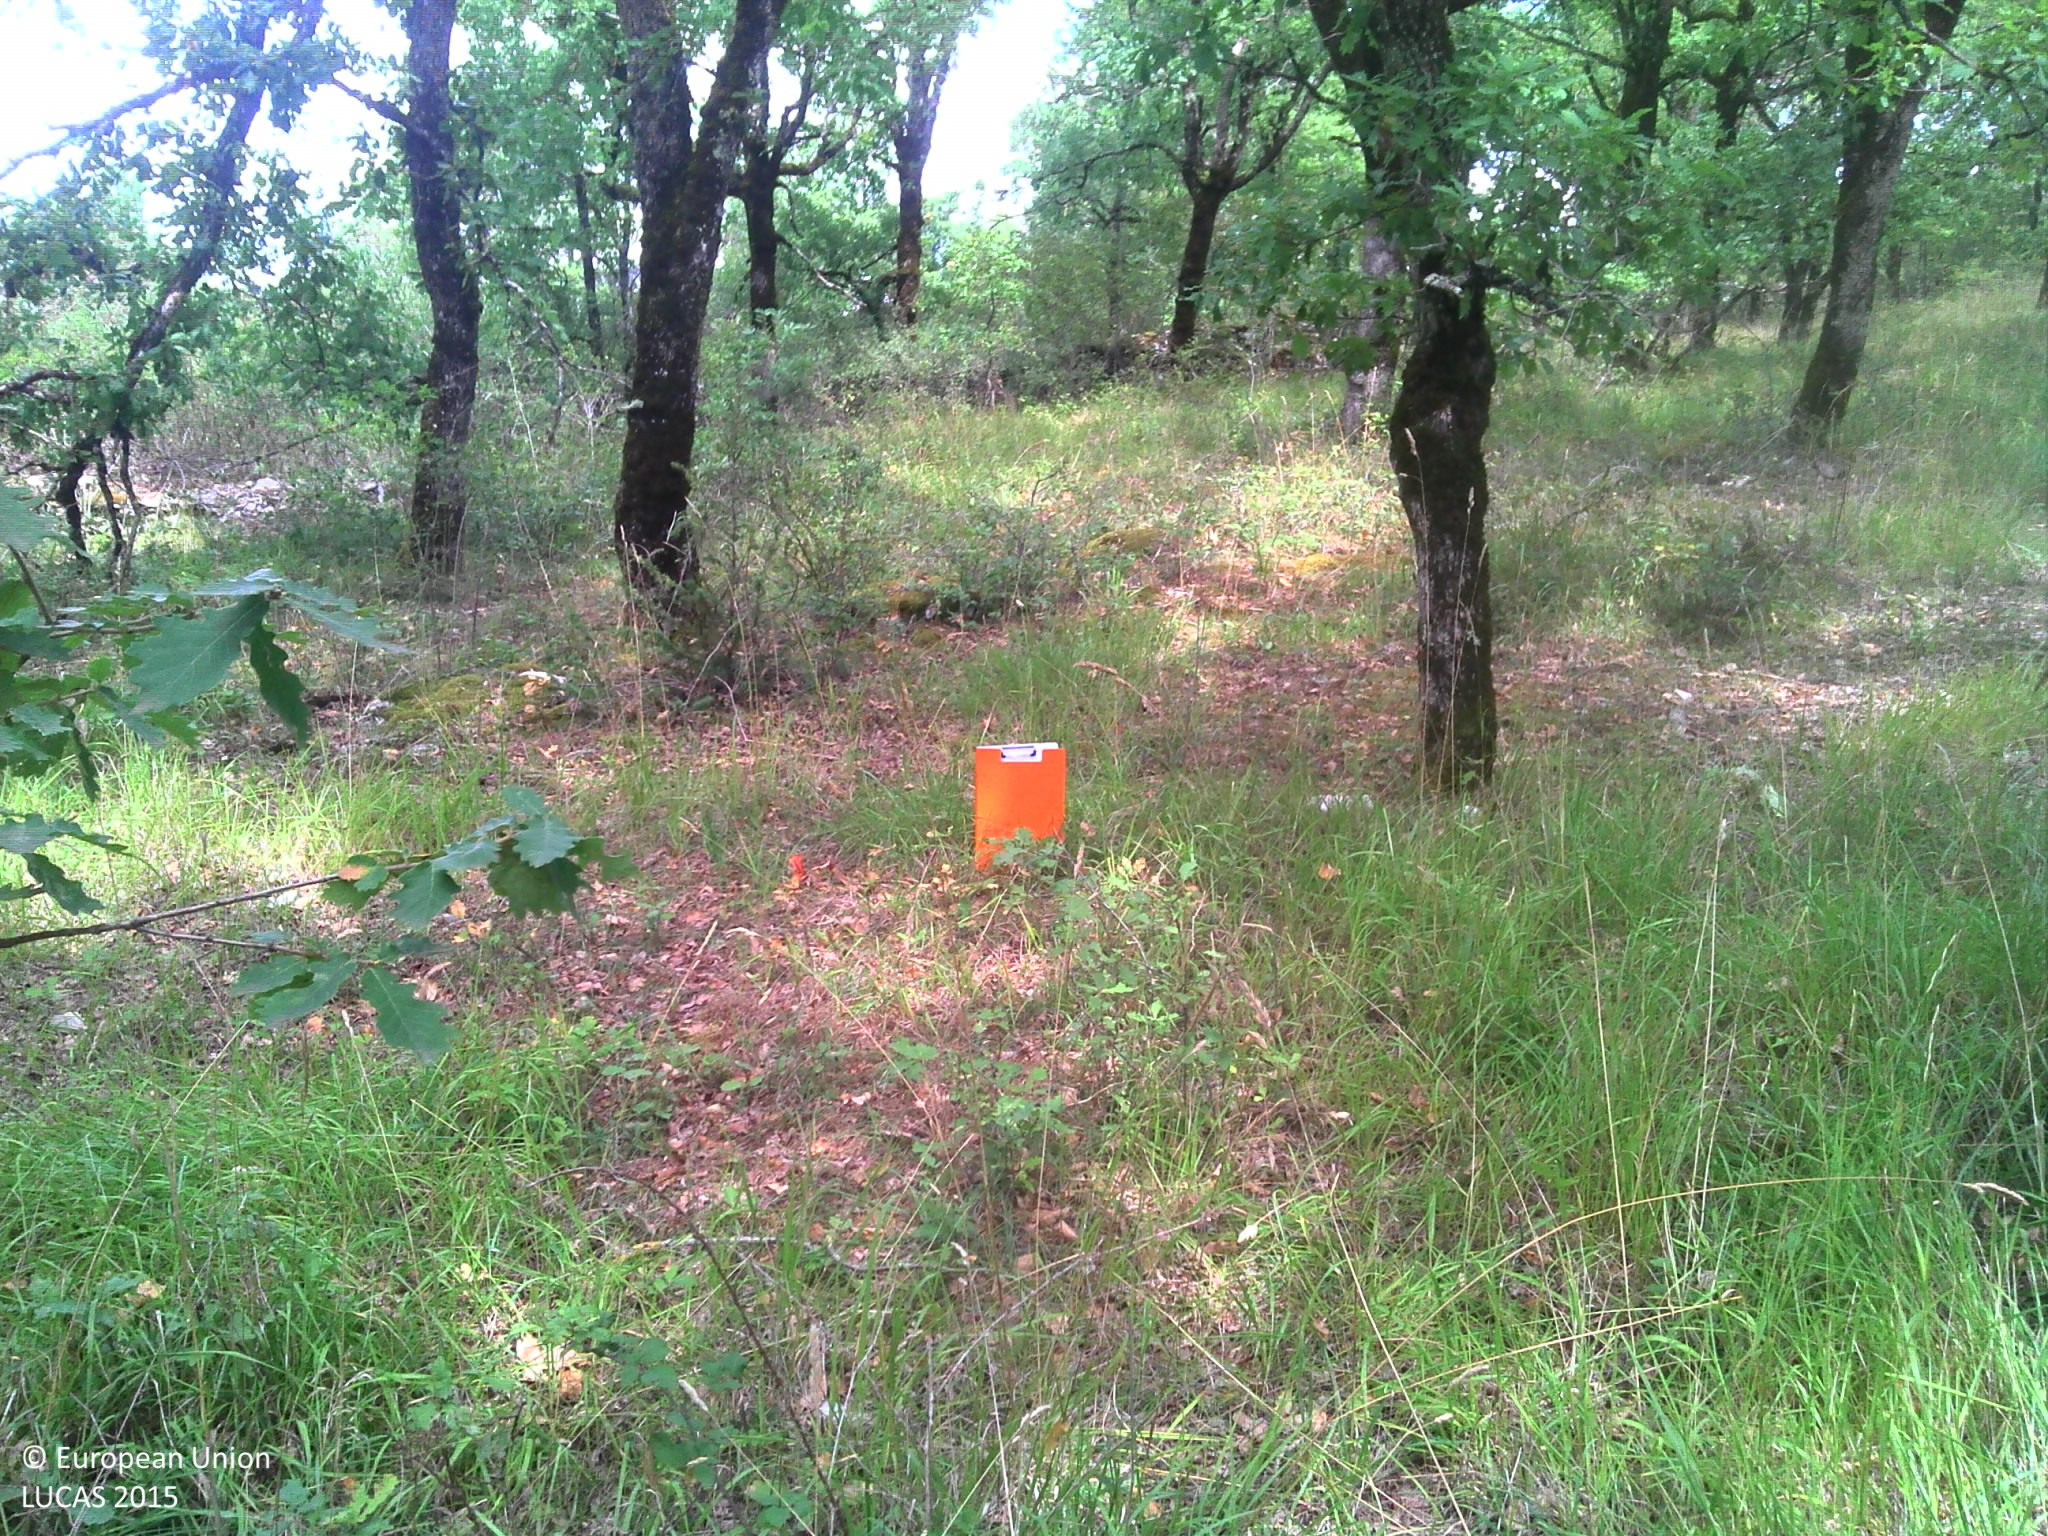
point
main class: Woodland
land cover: Broadleaved woodland
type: thermophilous deciduous forest
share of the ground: > 75 %
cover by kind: broadleaved forest trees 80 %, shrubs 10 %, herbaceous plants 10 %
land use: Forestry
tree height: > 5 m
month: August
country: FR
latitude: 44.8579
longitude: 1.7851
